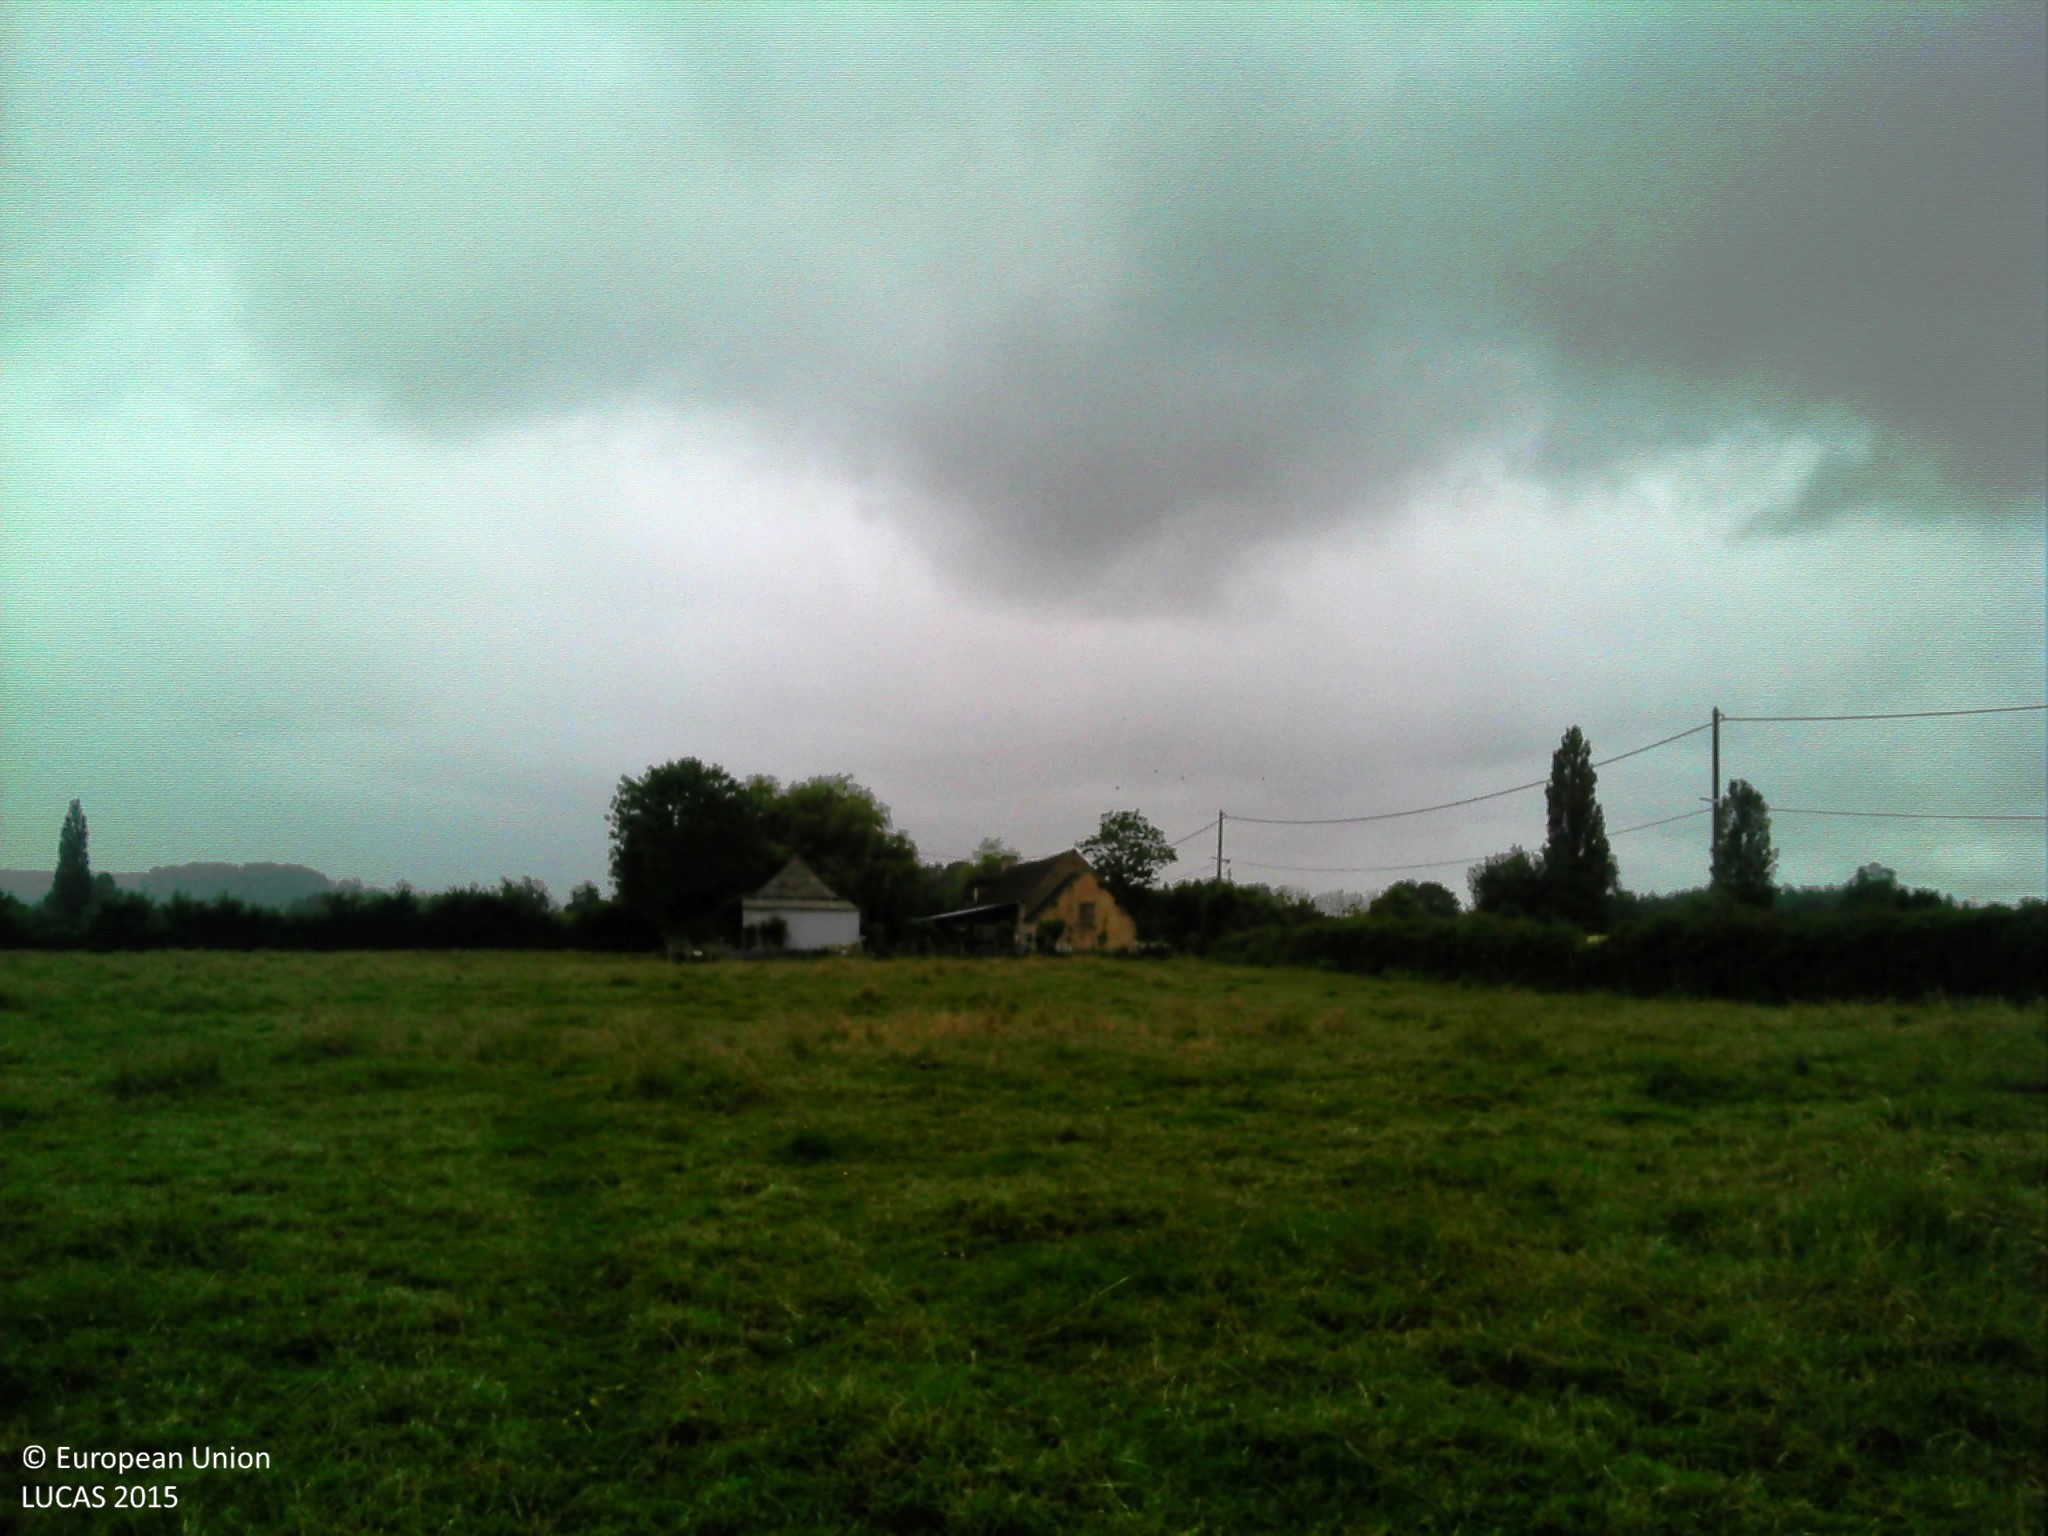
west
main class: Grassland
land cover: Grassland without tree/shrub cover
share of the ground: > 75 %
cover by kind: herbaceous plants 100 %
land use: Agriculture (excluding fallow land and kitchen gardens)
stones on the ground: < 10 %
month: June
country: FR
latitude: 48.1557
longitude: 0.2818
